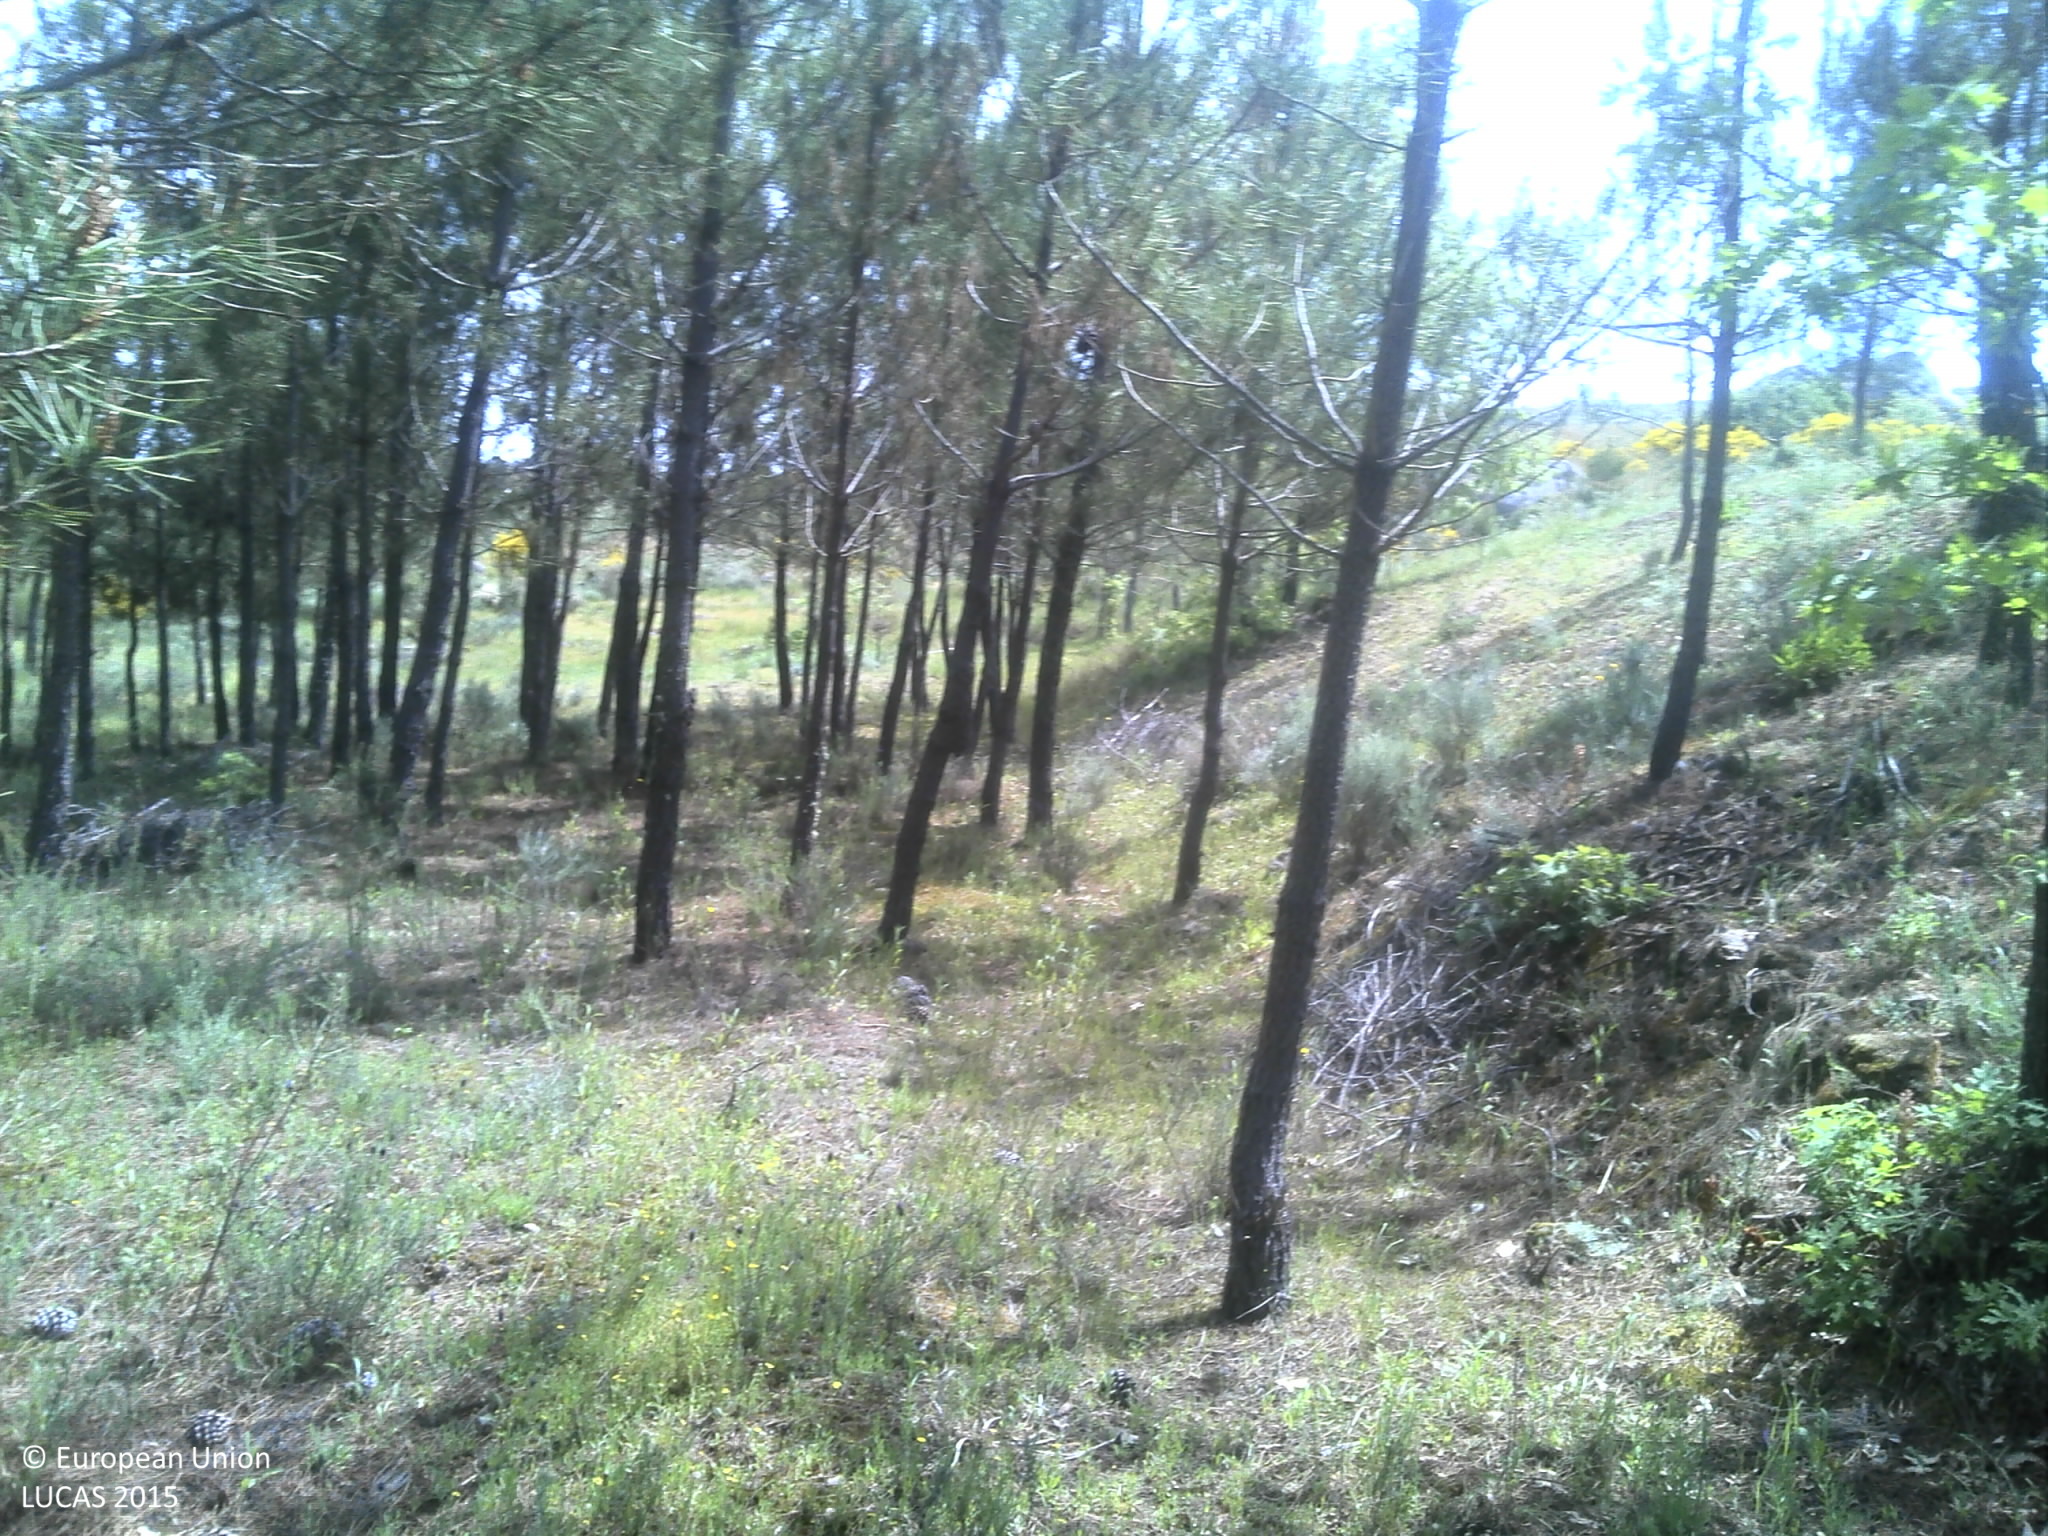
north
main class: Woodland
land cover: Pine dominated coniferous woodland
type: coniferous forest of the mediterranean region
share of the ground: 25 - 50 %
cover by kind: coniferous forest trees 50 %, shrubs 20 %, herbaceous plants 15 %, unconsolidated bare surface 15 %
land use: Forestry
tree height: > 5 m
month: May
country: PT
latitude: 40.7143
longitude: -7.4797
